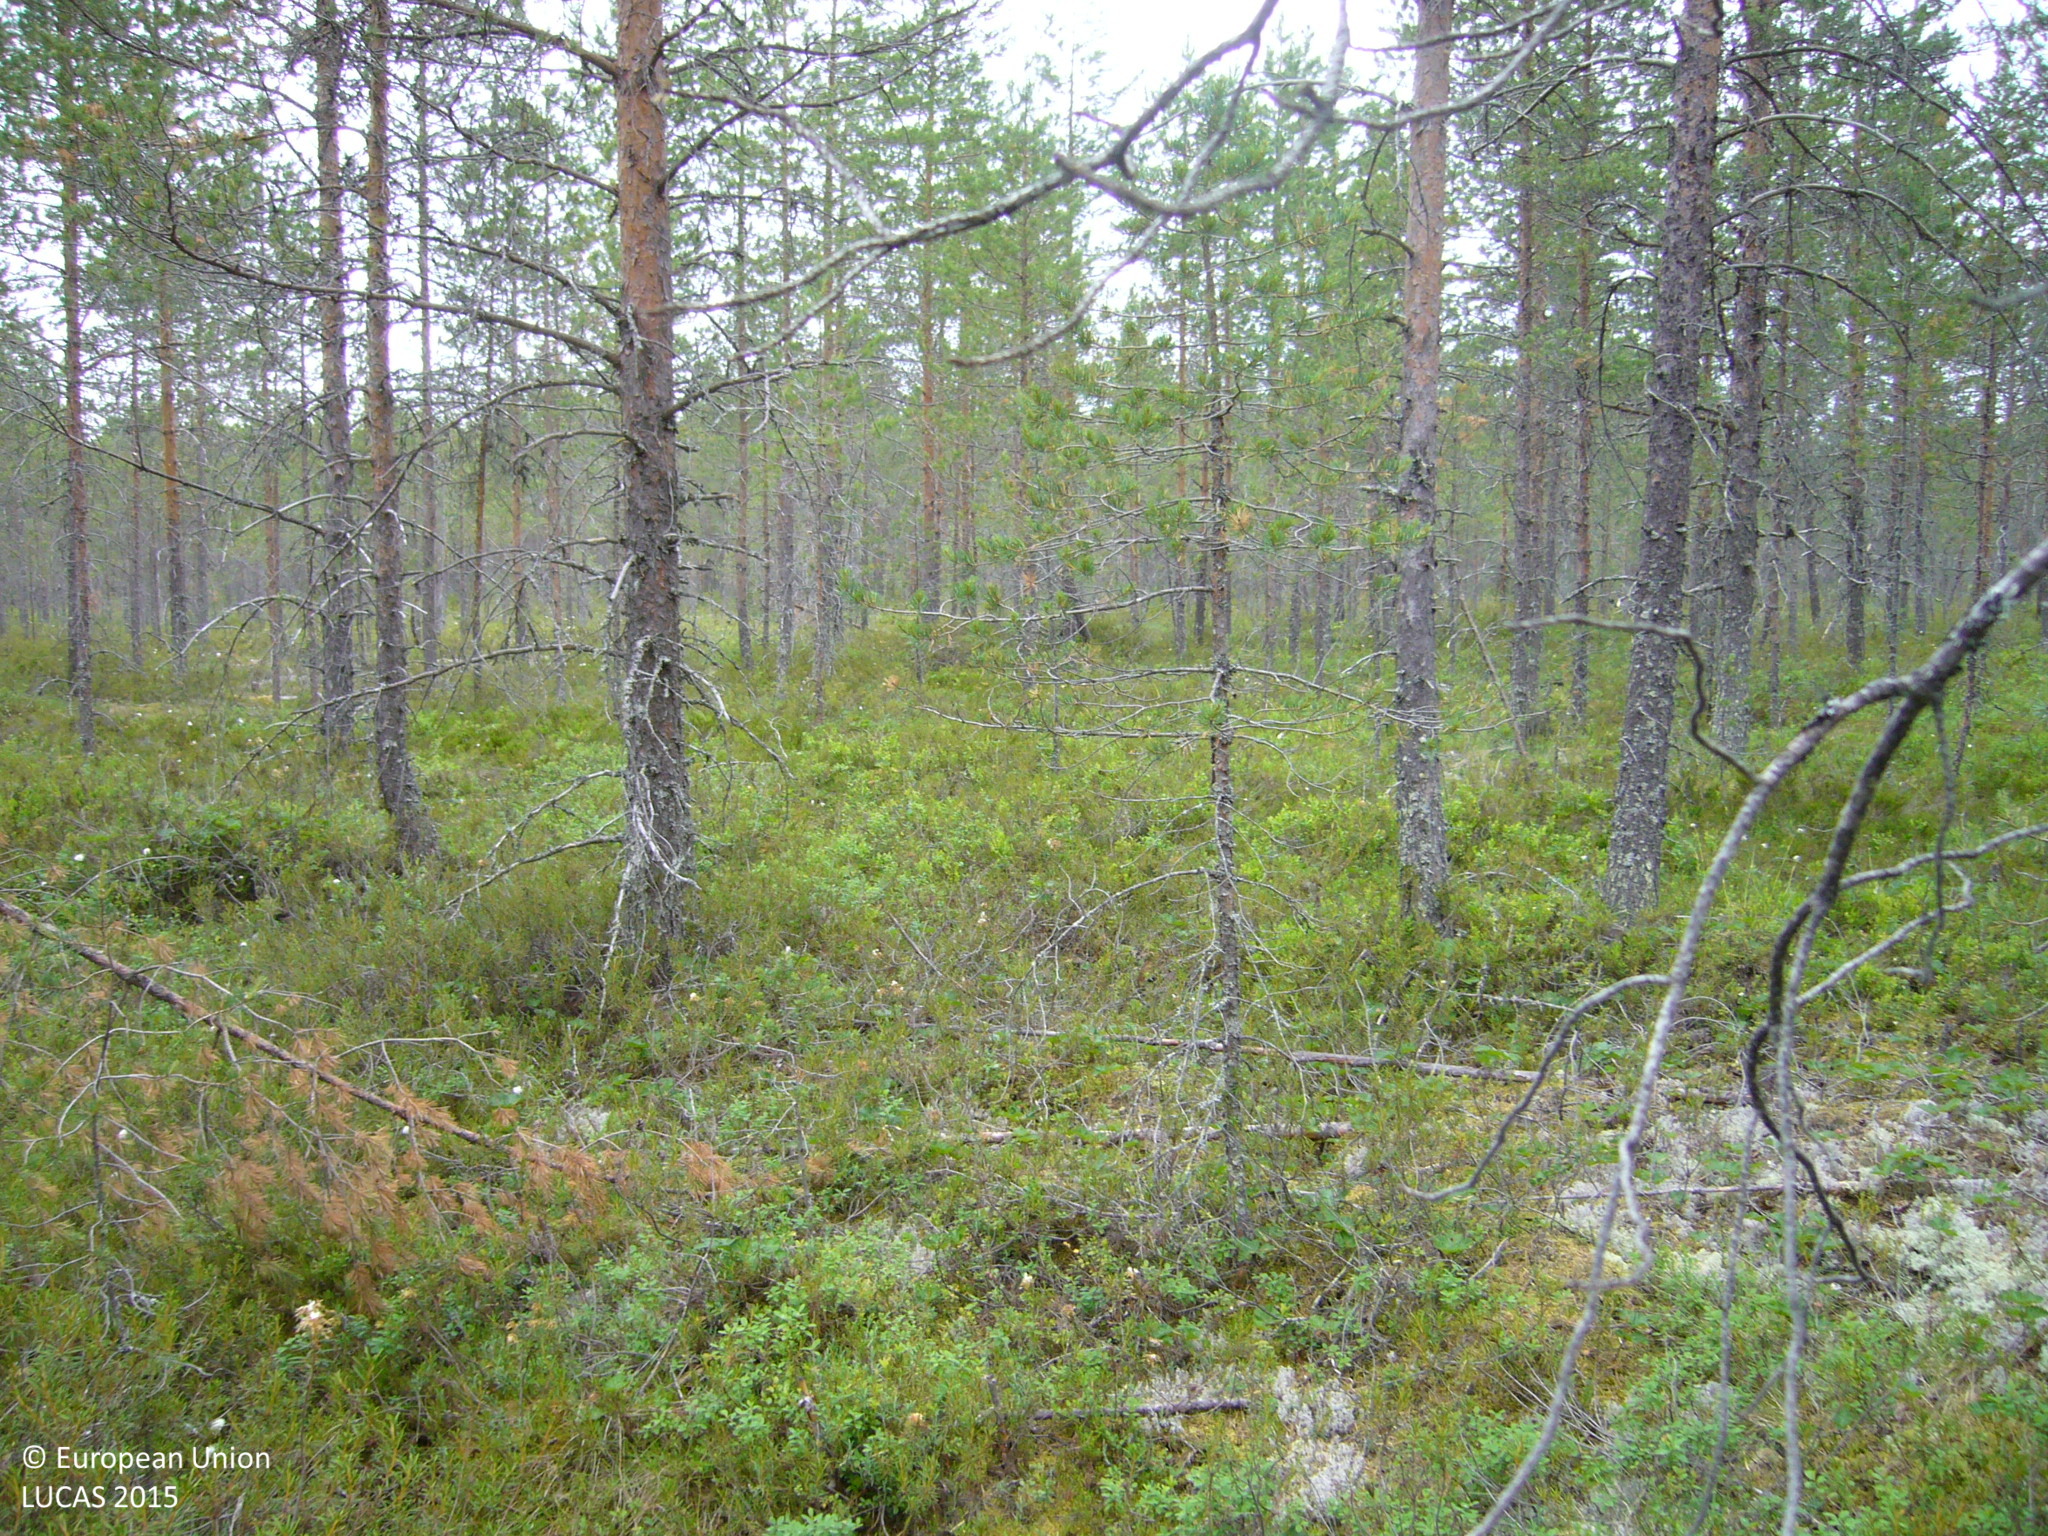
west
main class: Woodland
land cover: Pine dominated coniferous woodland
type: boreal forest
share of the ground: 50 - 75 %
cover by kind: coniferous forest trees 60 %, shrubs 40 %
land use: Forestry
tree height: > 5 m
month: July
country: FI
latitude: 63.4635
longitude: 25.8593
